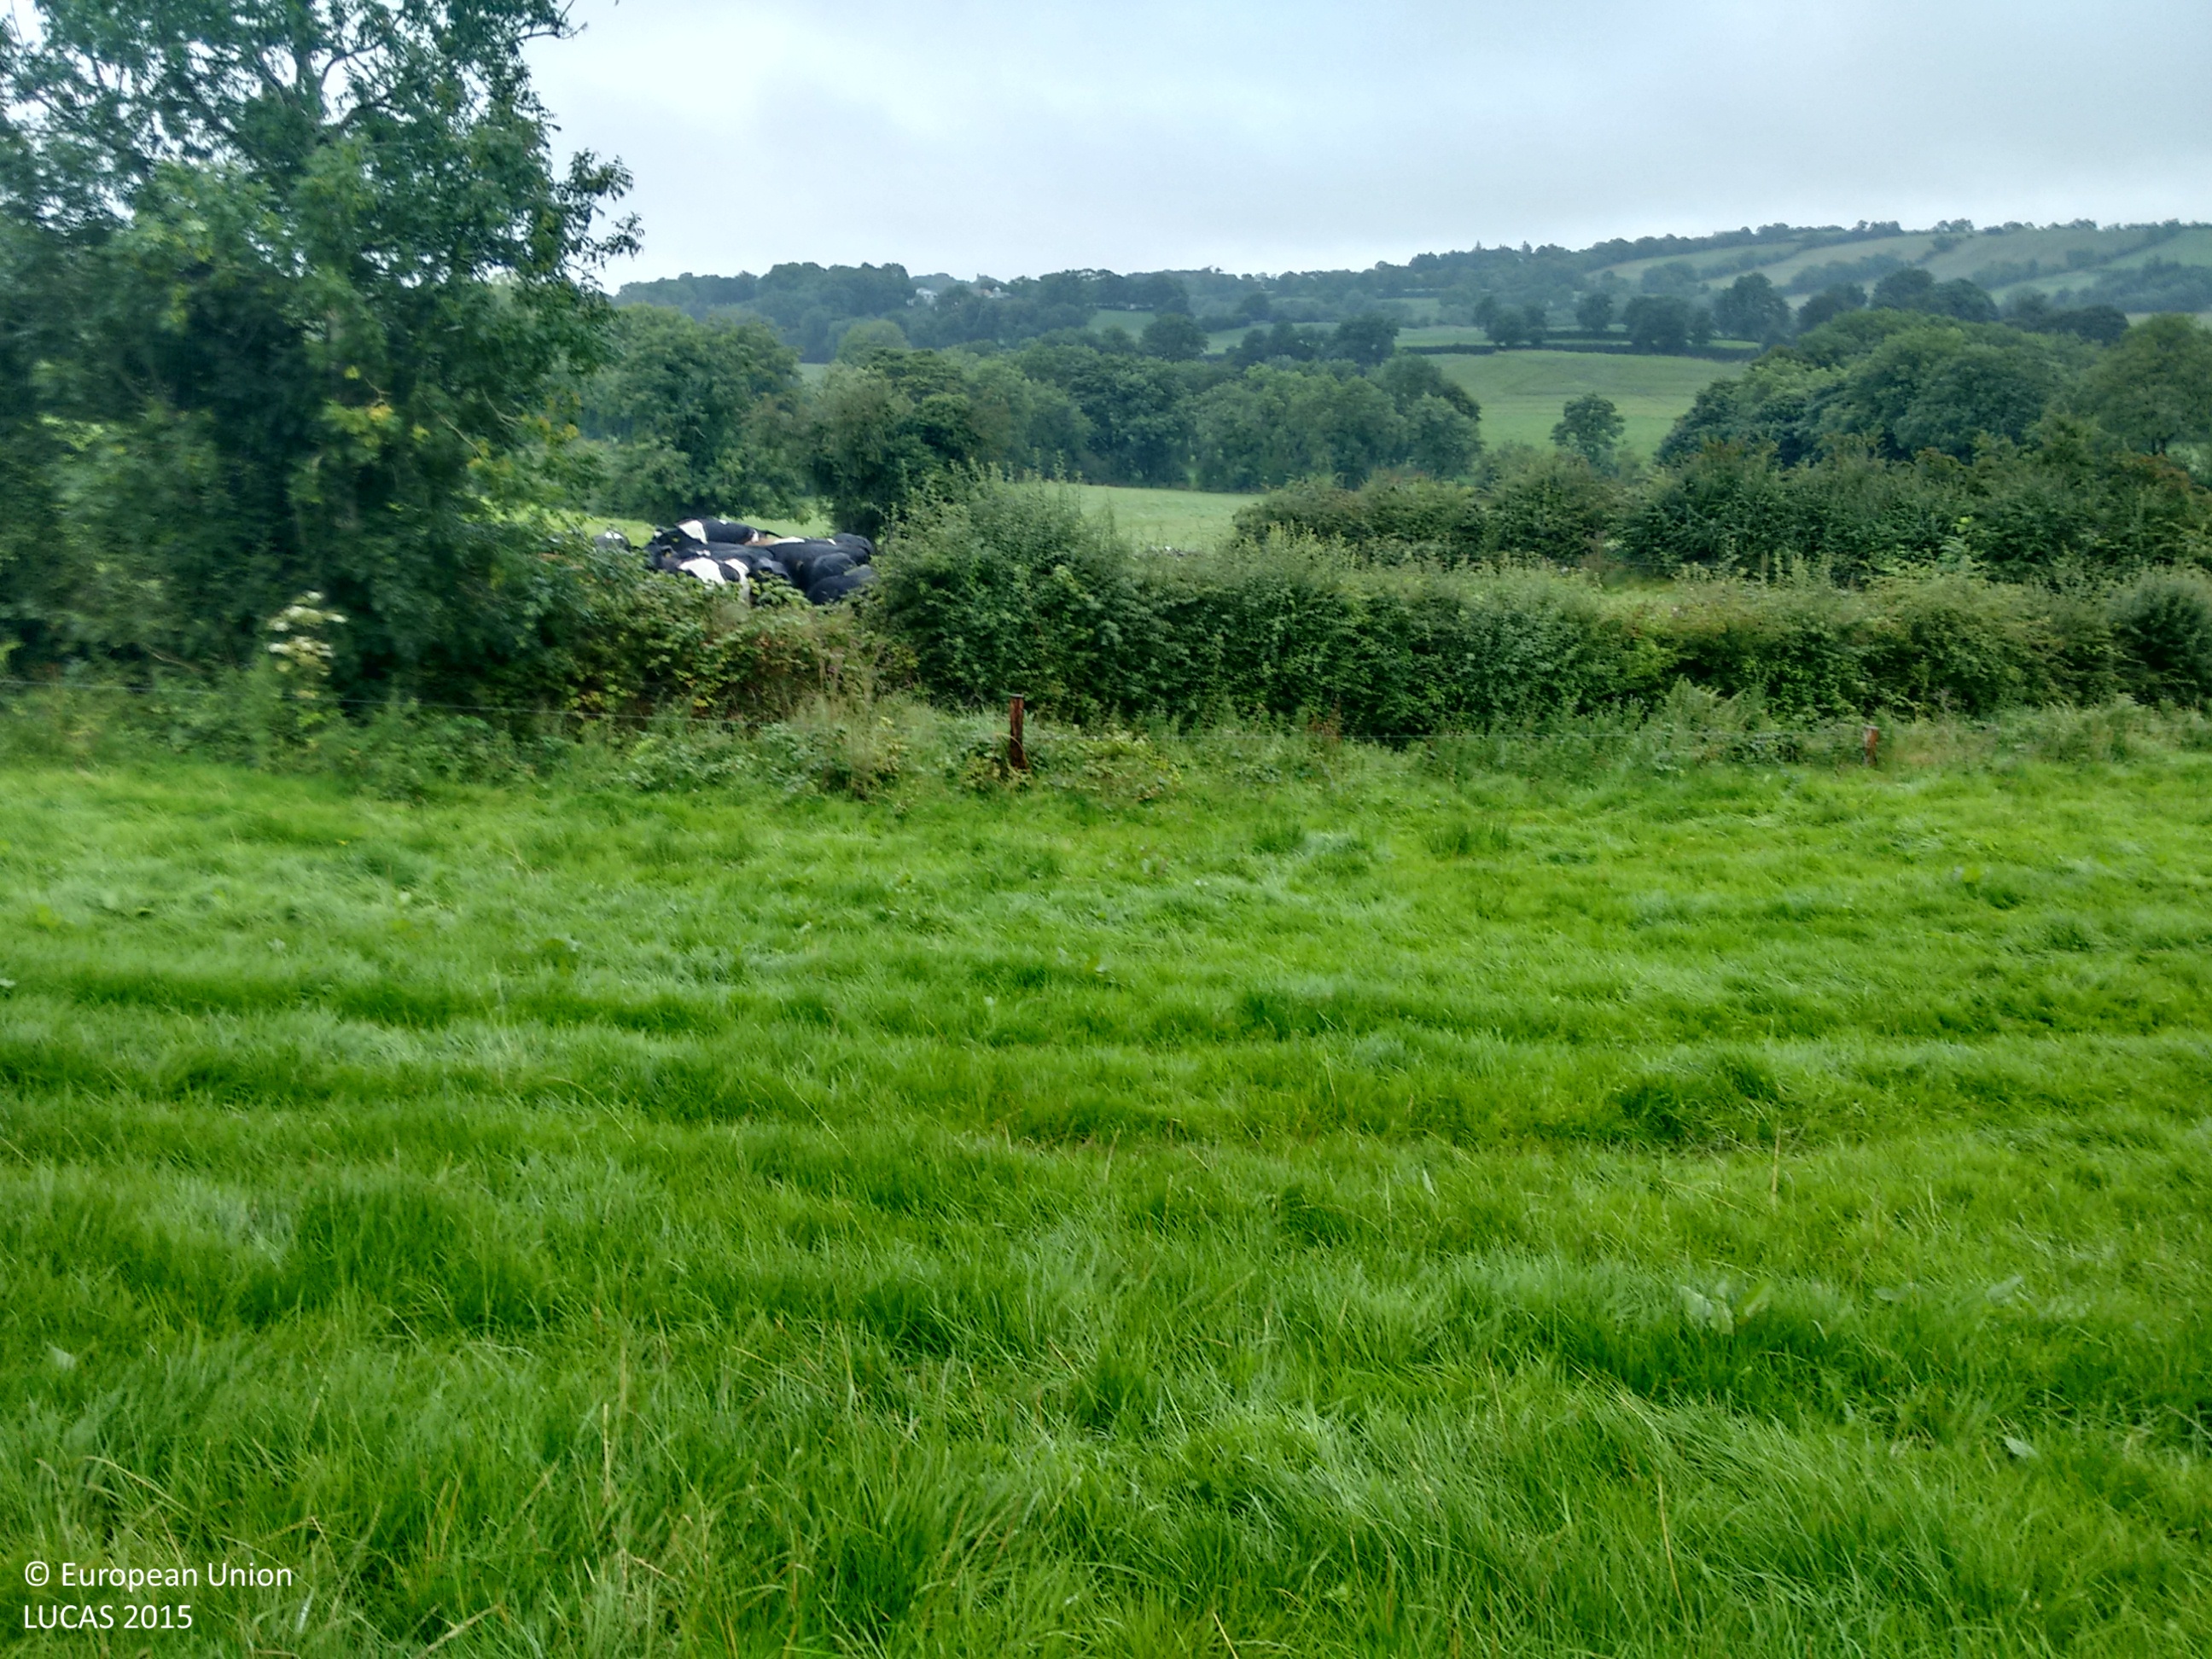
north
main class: Grassland
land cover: Grassland without tree/shrub cover
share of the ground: > 75 %
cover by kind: herbaceous plants 100 %
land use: Agriculture (excluding fallow land and kitchen gardens)
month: August
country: IE
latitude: 53.8575
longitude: -7.1592
